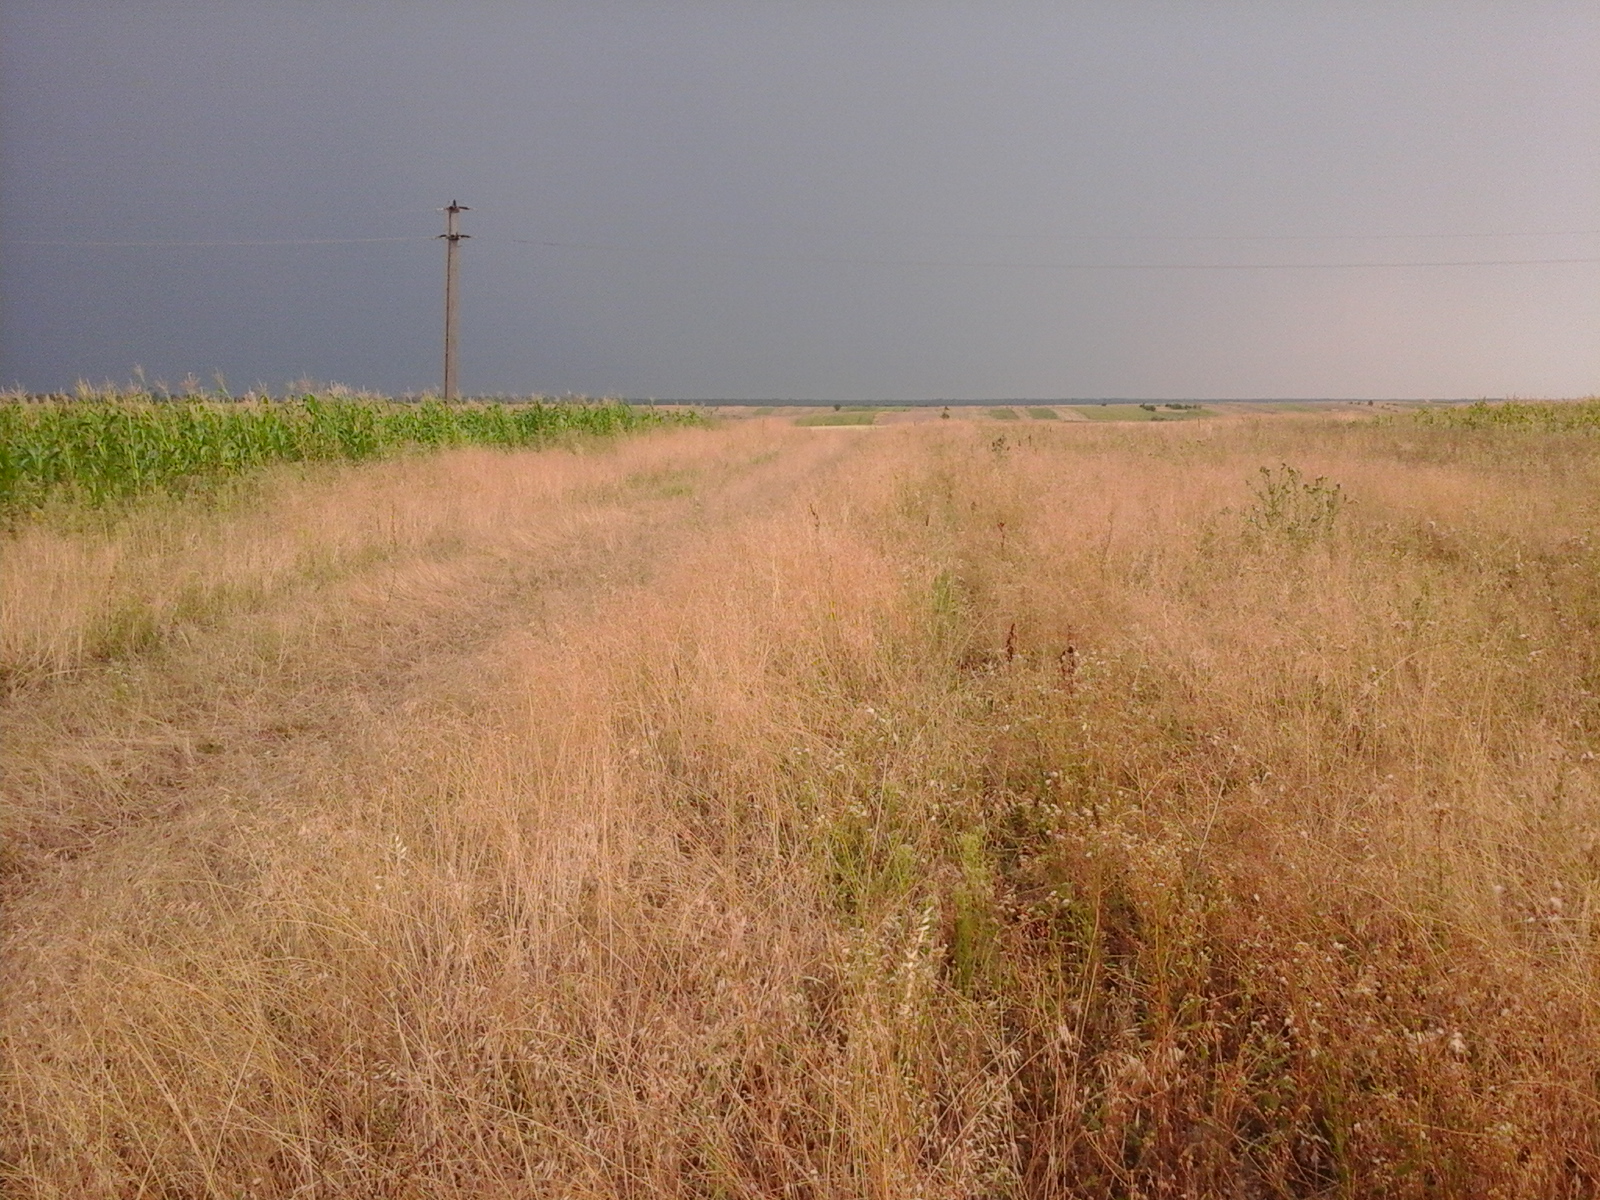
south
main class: Grassland
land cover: Grassland without tree/shrub cover
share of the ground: > 75 %
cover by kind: herbaceous plants 100 %
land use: Agriculture (excluding fallow land and kitchen gardens)
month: August
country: RO
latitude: 44.3858
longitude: 23.2919
